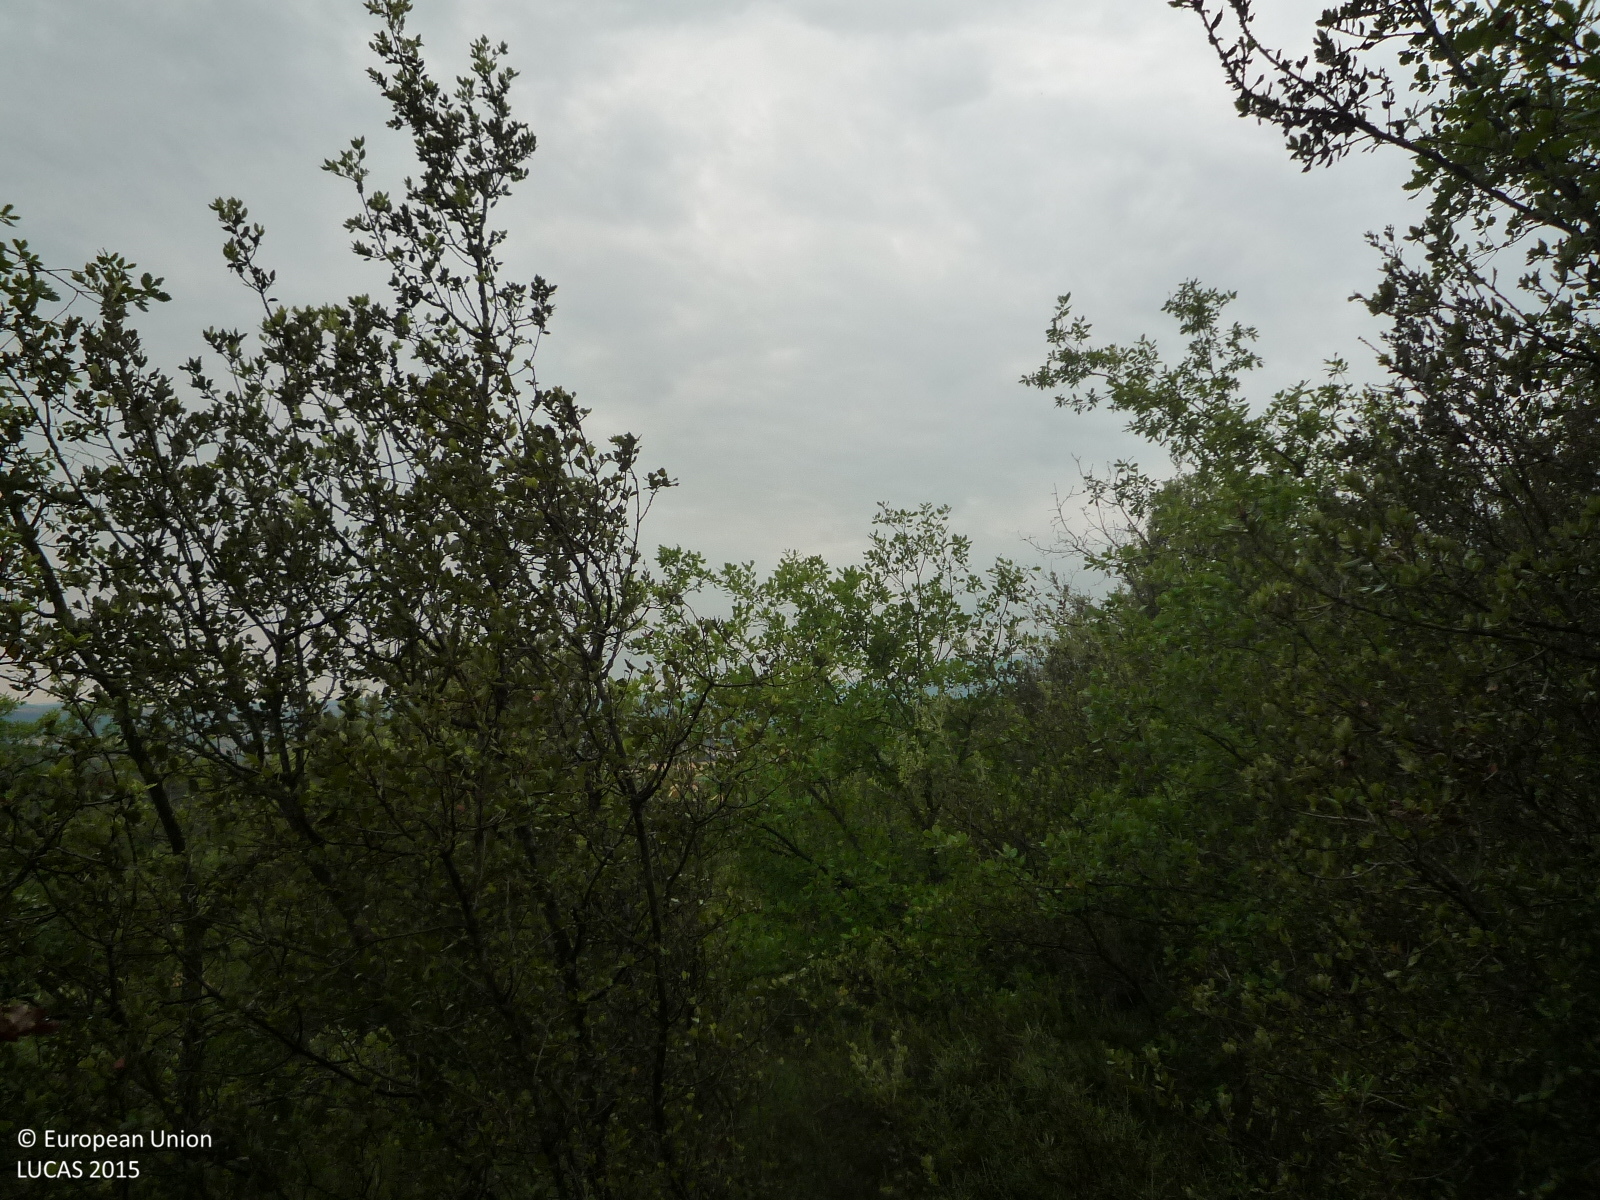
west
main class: Woodland
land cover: Broadleaved woodland
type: broadleaved evergreen forest
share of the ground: > 75 %
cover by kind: broadleaved forest trees 80 %, herbaceous plants 20 %
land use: Forestry
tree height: < 5 m
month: June
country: ES
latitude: 42.0594
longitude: 1.9291
